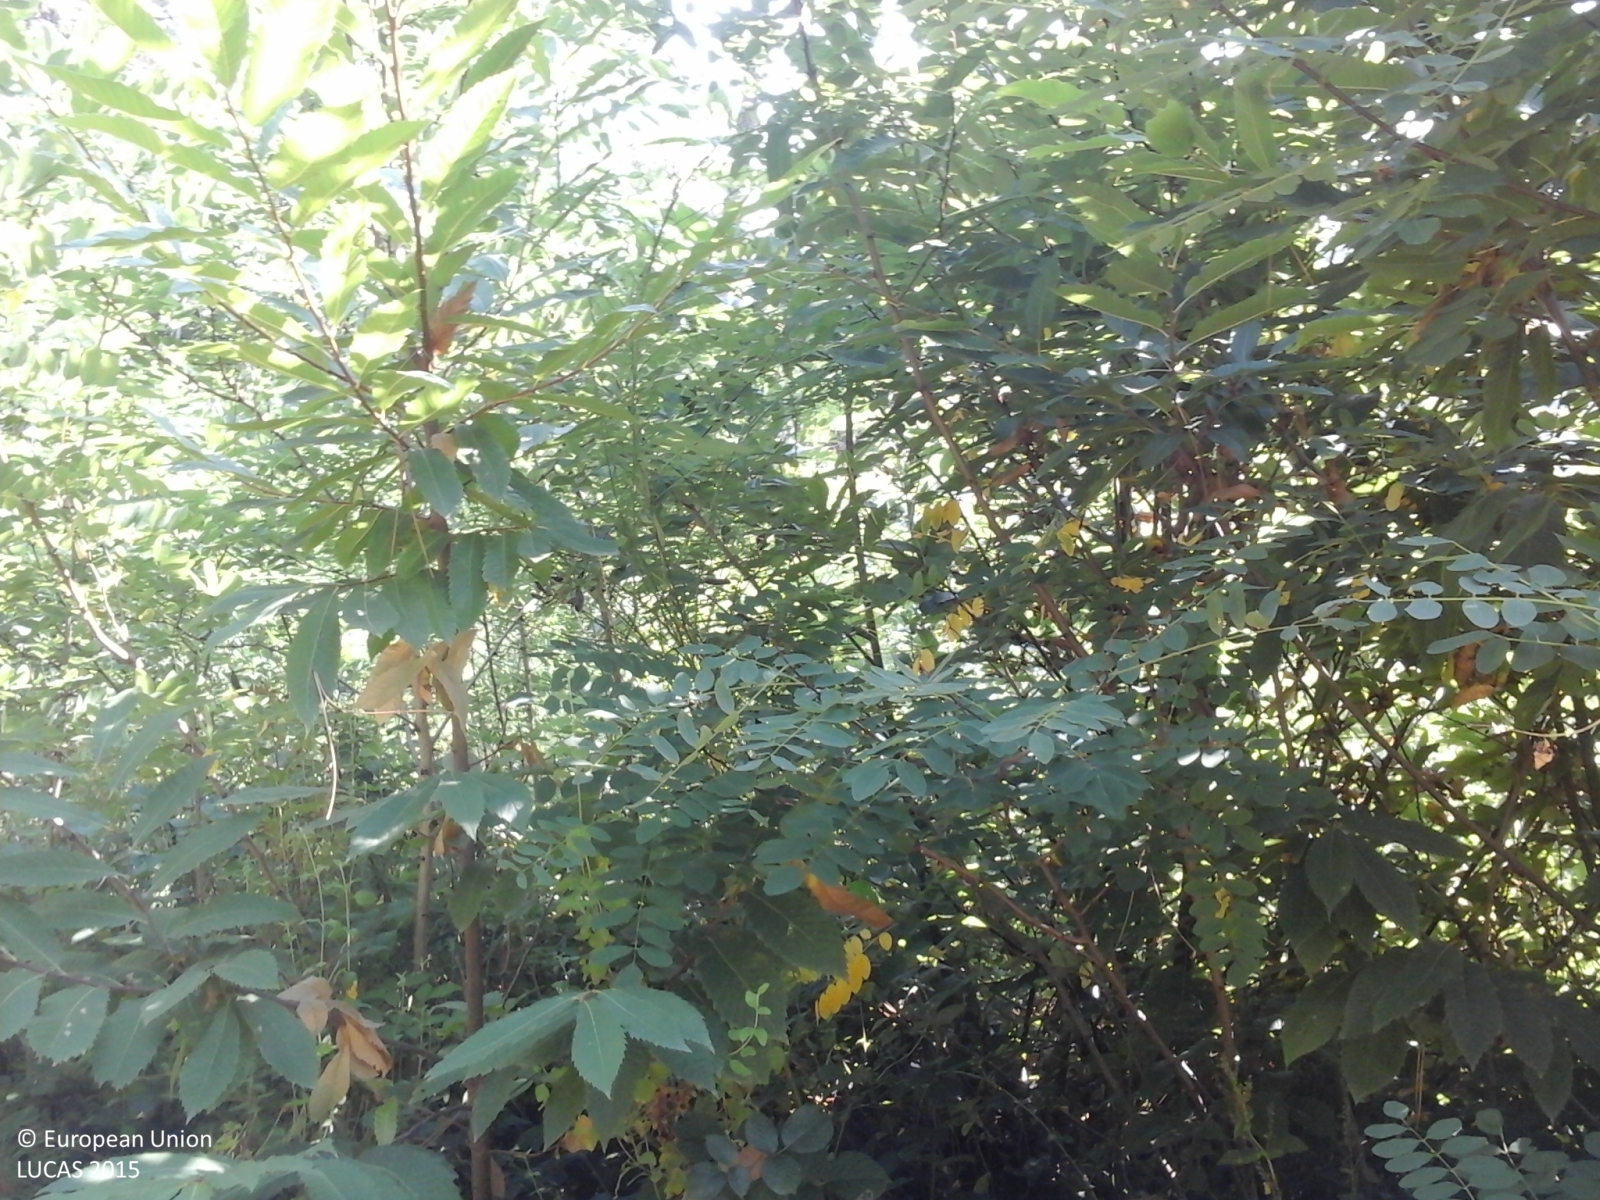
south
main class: Woodland
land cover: Other mixed woodland
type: thermophilous deciduous forest
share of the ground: > 75 %
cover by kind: broadleaved forest trees 60 %, coniferous forest trees 40 %
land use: Forestry
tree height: > 5 m
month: August
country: IT
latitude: 43.9329
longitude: 10.7579
